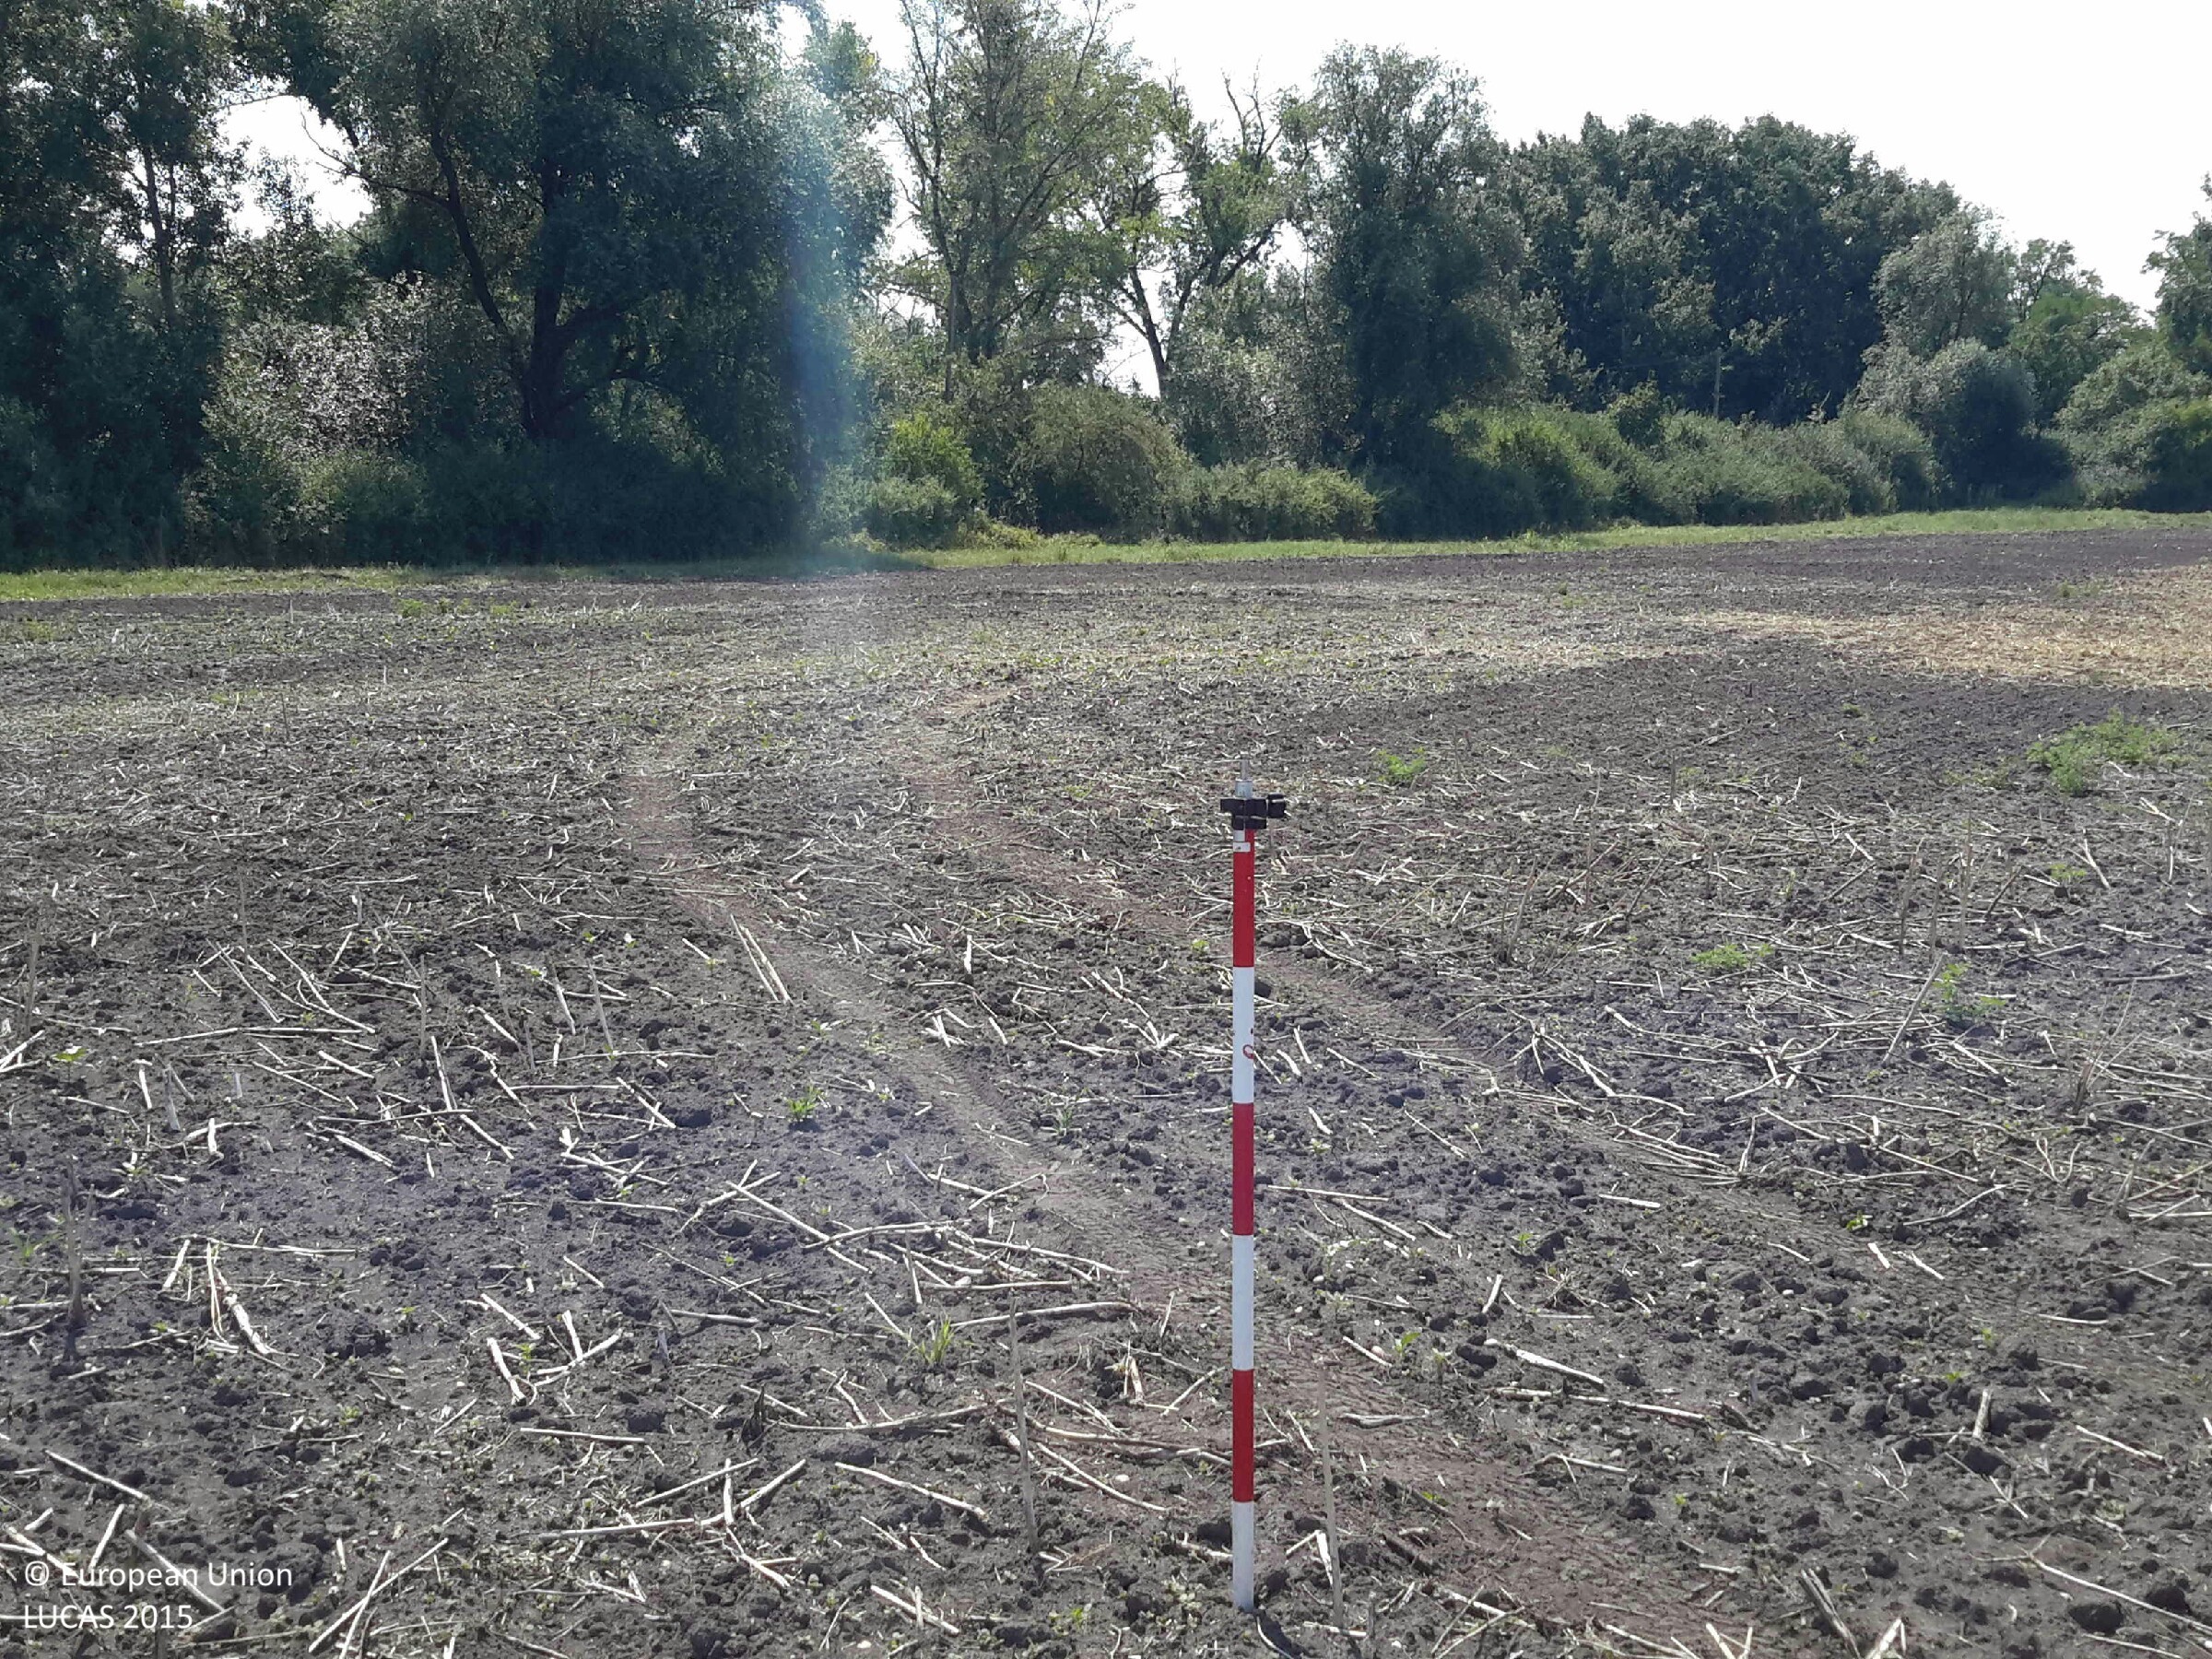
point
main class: Cropland
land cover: Rape and turnip rape
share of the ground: < 10 %
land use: Agriculture (excluding fallow land and kitchen gardens)
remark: Harvested field
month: August
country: HU
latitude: 47.7585
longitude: 17.1175
